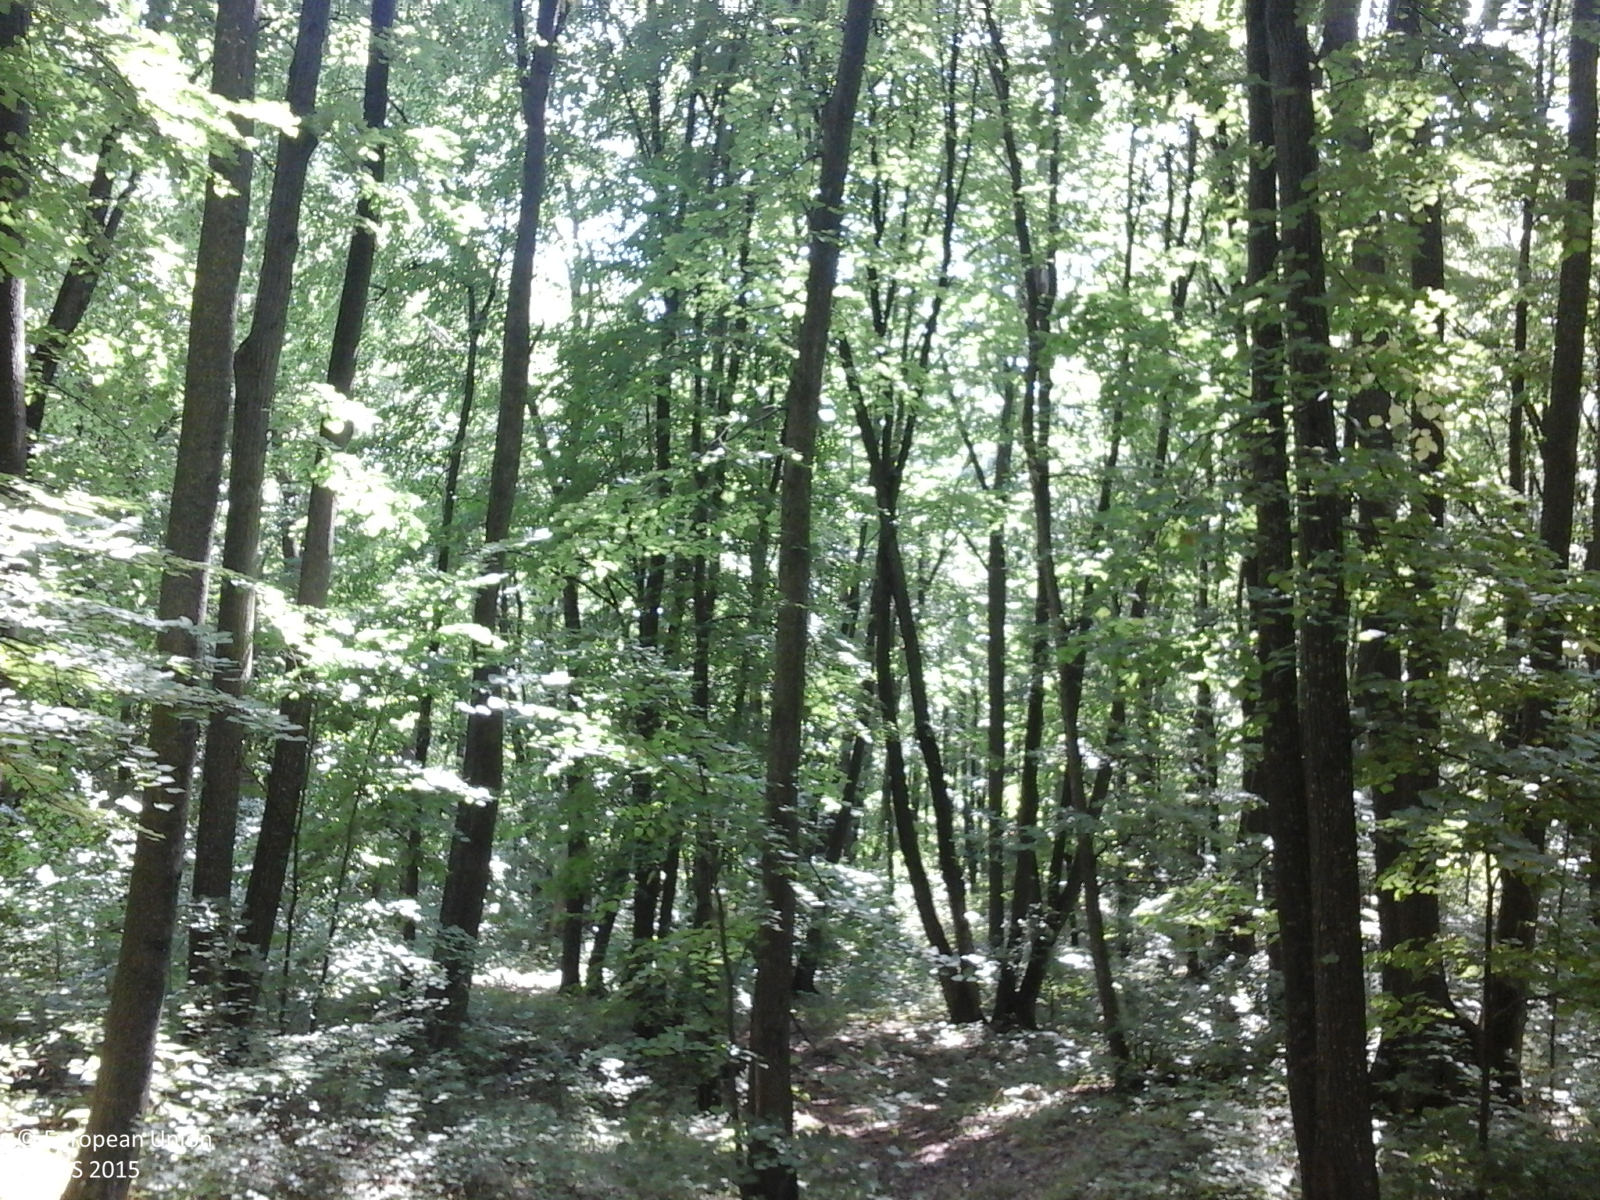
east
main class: Woodland
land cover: Broadleaved woodland
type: beech forest
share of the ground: > 75 %
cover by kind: broadleaved forest trees 90 %, shrubs 5 %, herbaceous plants 5 %
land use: Forestry
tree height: > 5 m
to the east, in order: Broadleaved woodland; Tracks; Broadleaved woodland
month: June
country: RO
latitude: 46.8204
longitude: 27.3176
